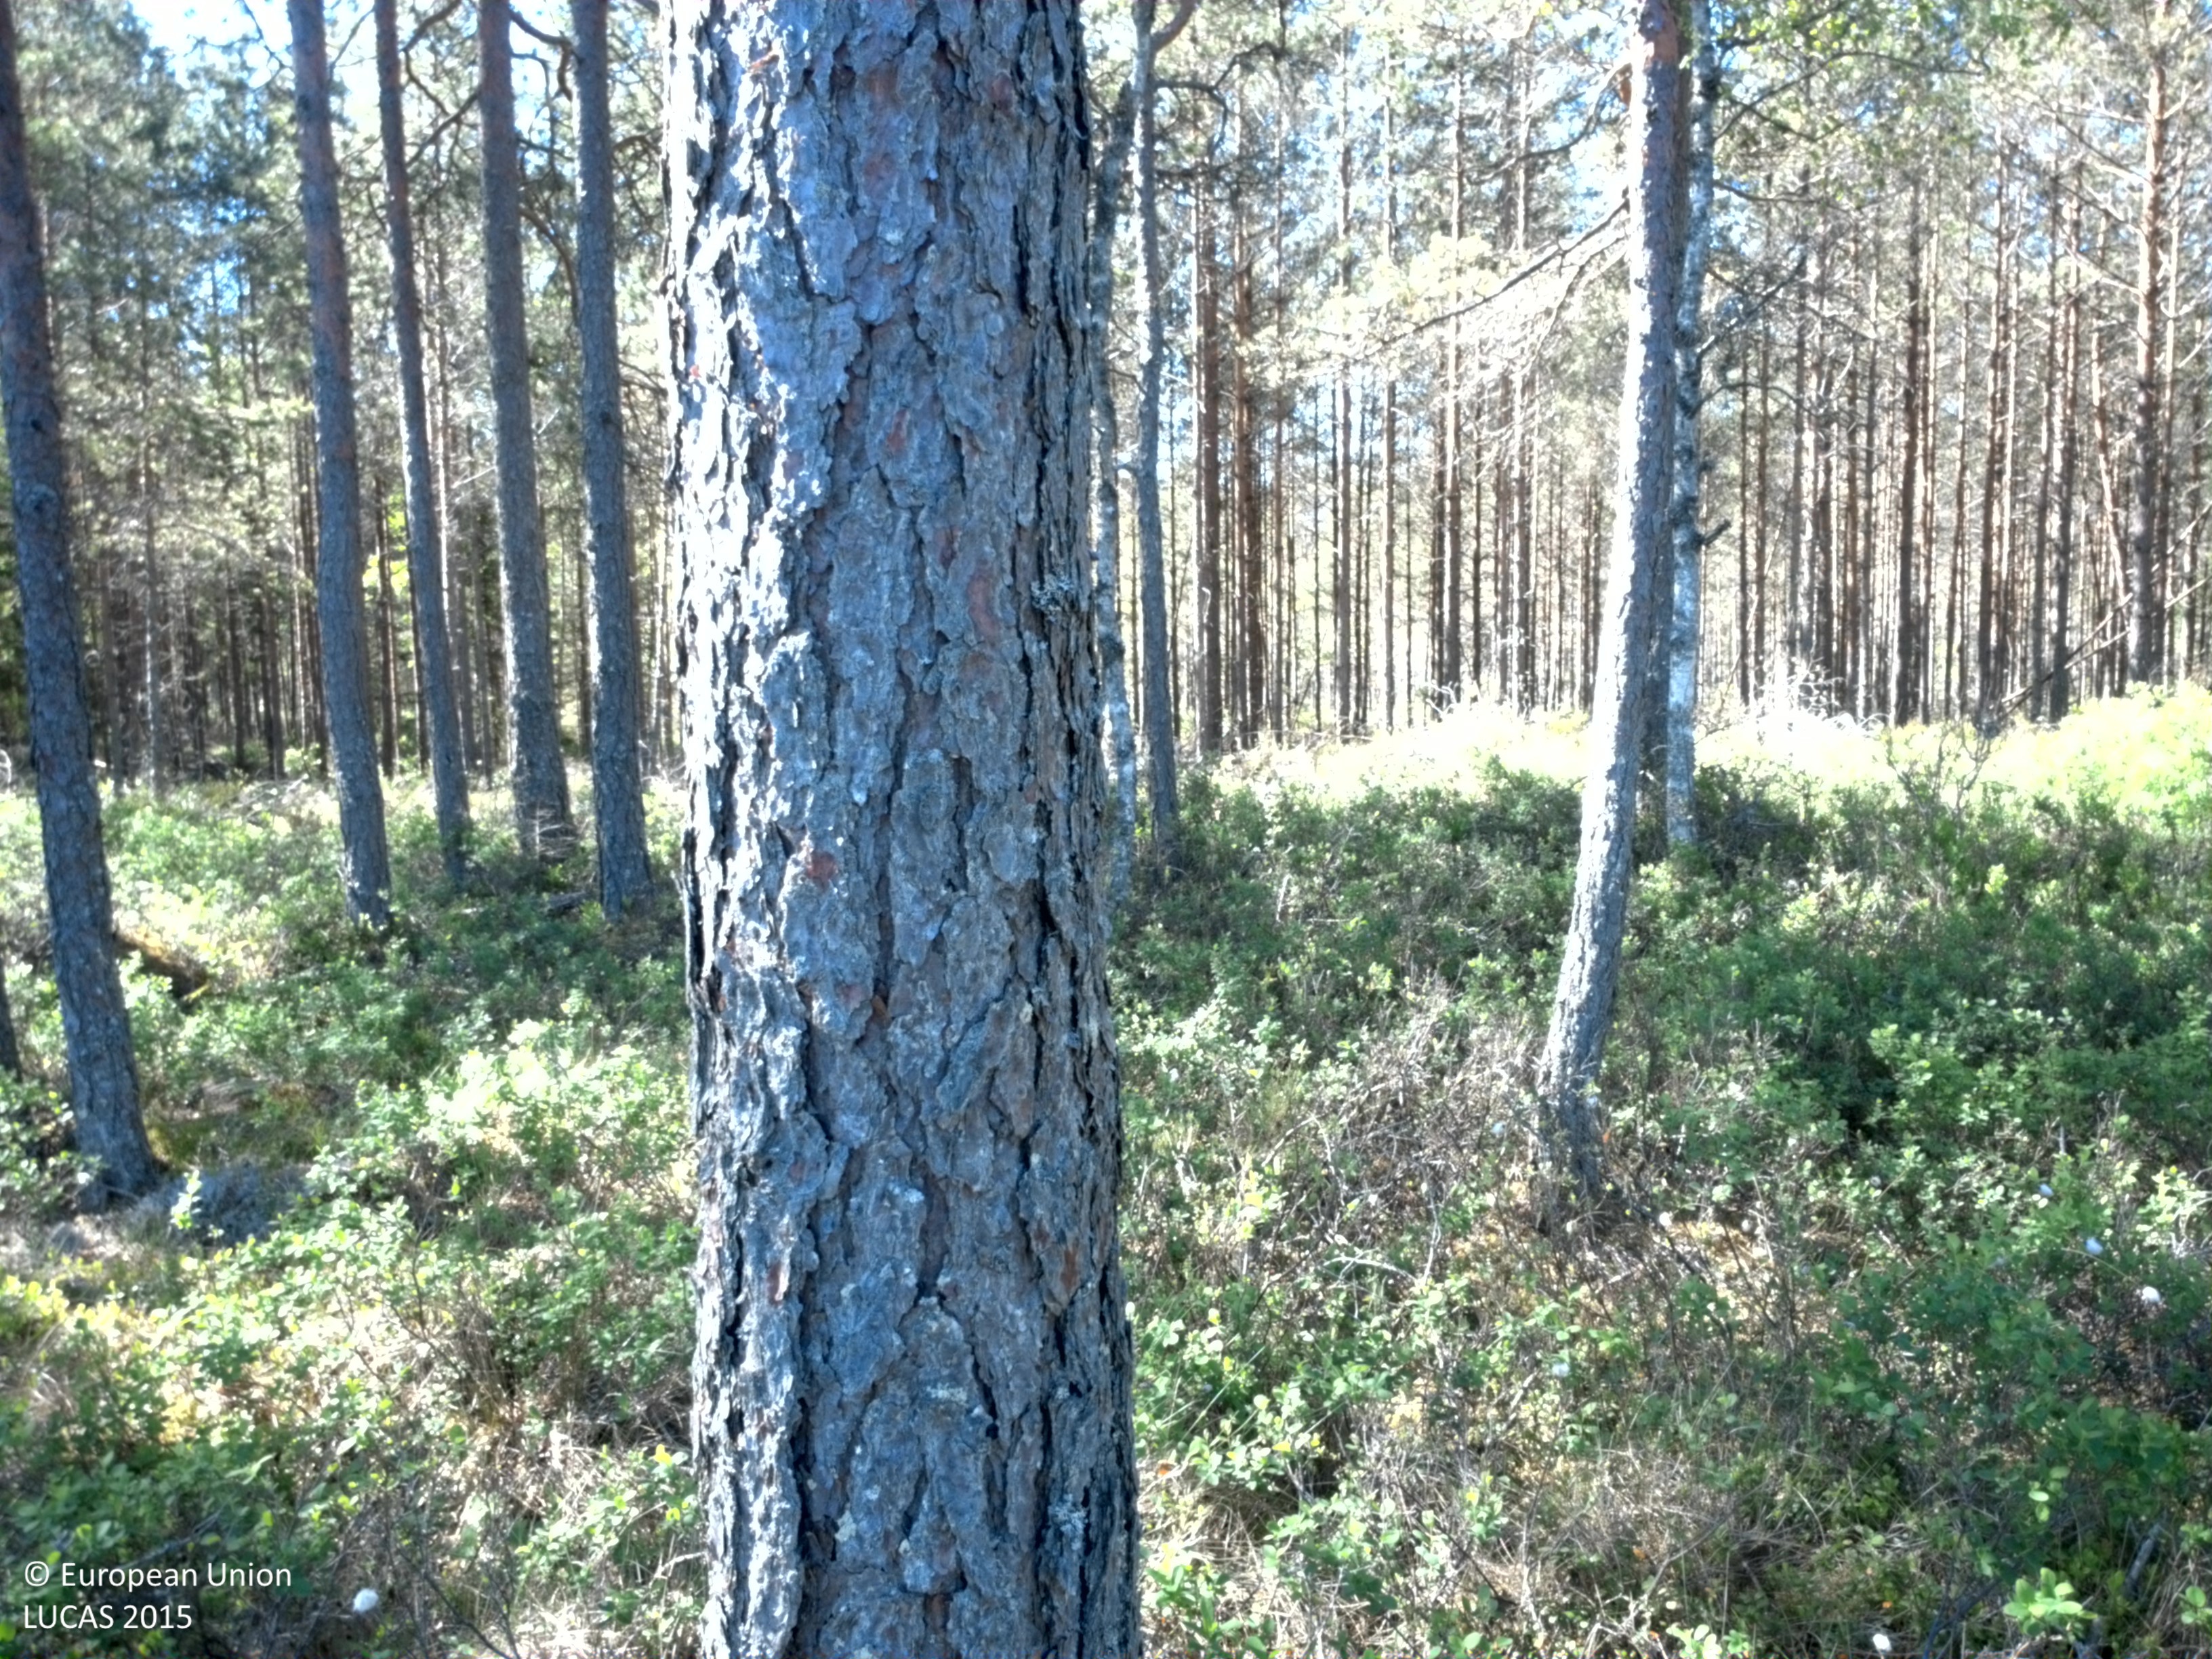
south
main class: Woodland
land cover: Pine dominated coniferous woodland
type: boreal forest
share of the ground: 50 - 75 %
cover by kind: coniferous forest trees 50 %, shrubs 25 %, herbaceous plants 10 %, lichens and mosses 10 %, broadleaved forest trees 5 %
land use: Forestry
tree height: > 5 m
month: June
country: SE
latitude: 59.4994
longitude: 12.0613
